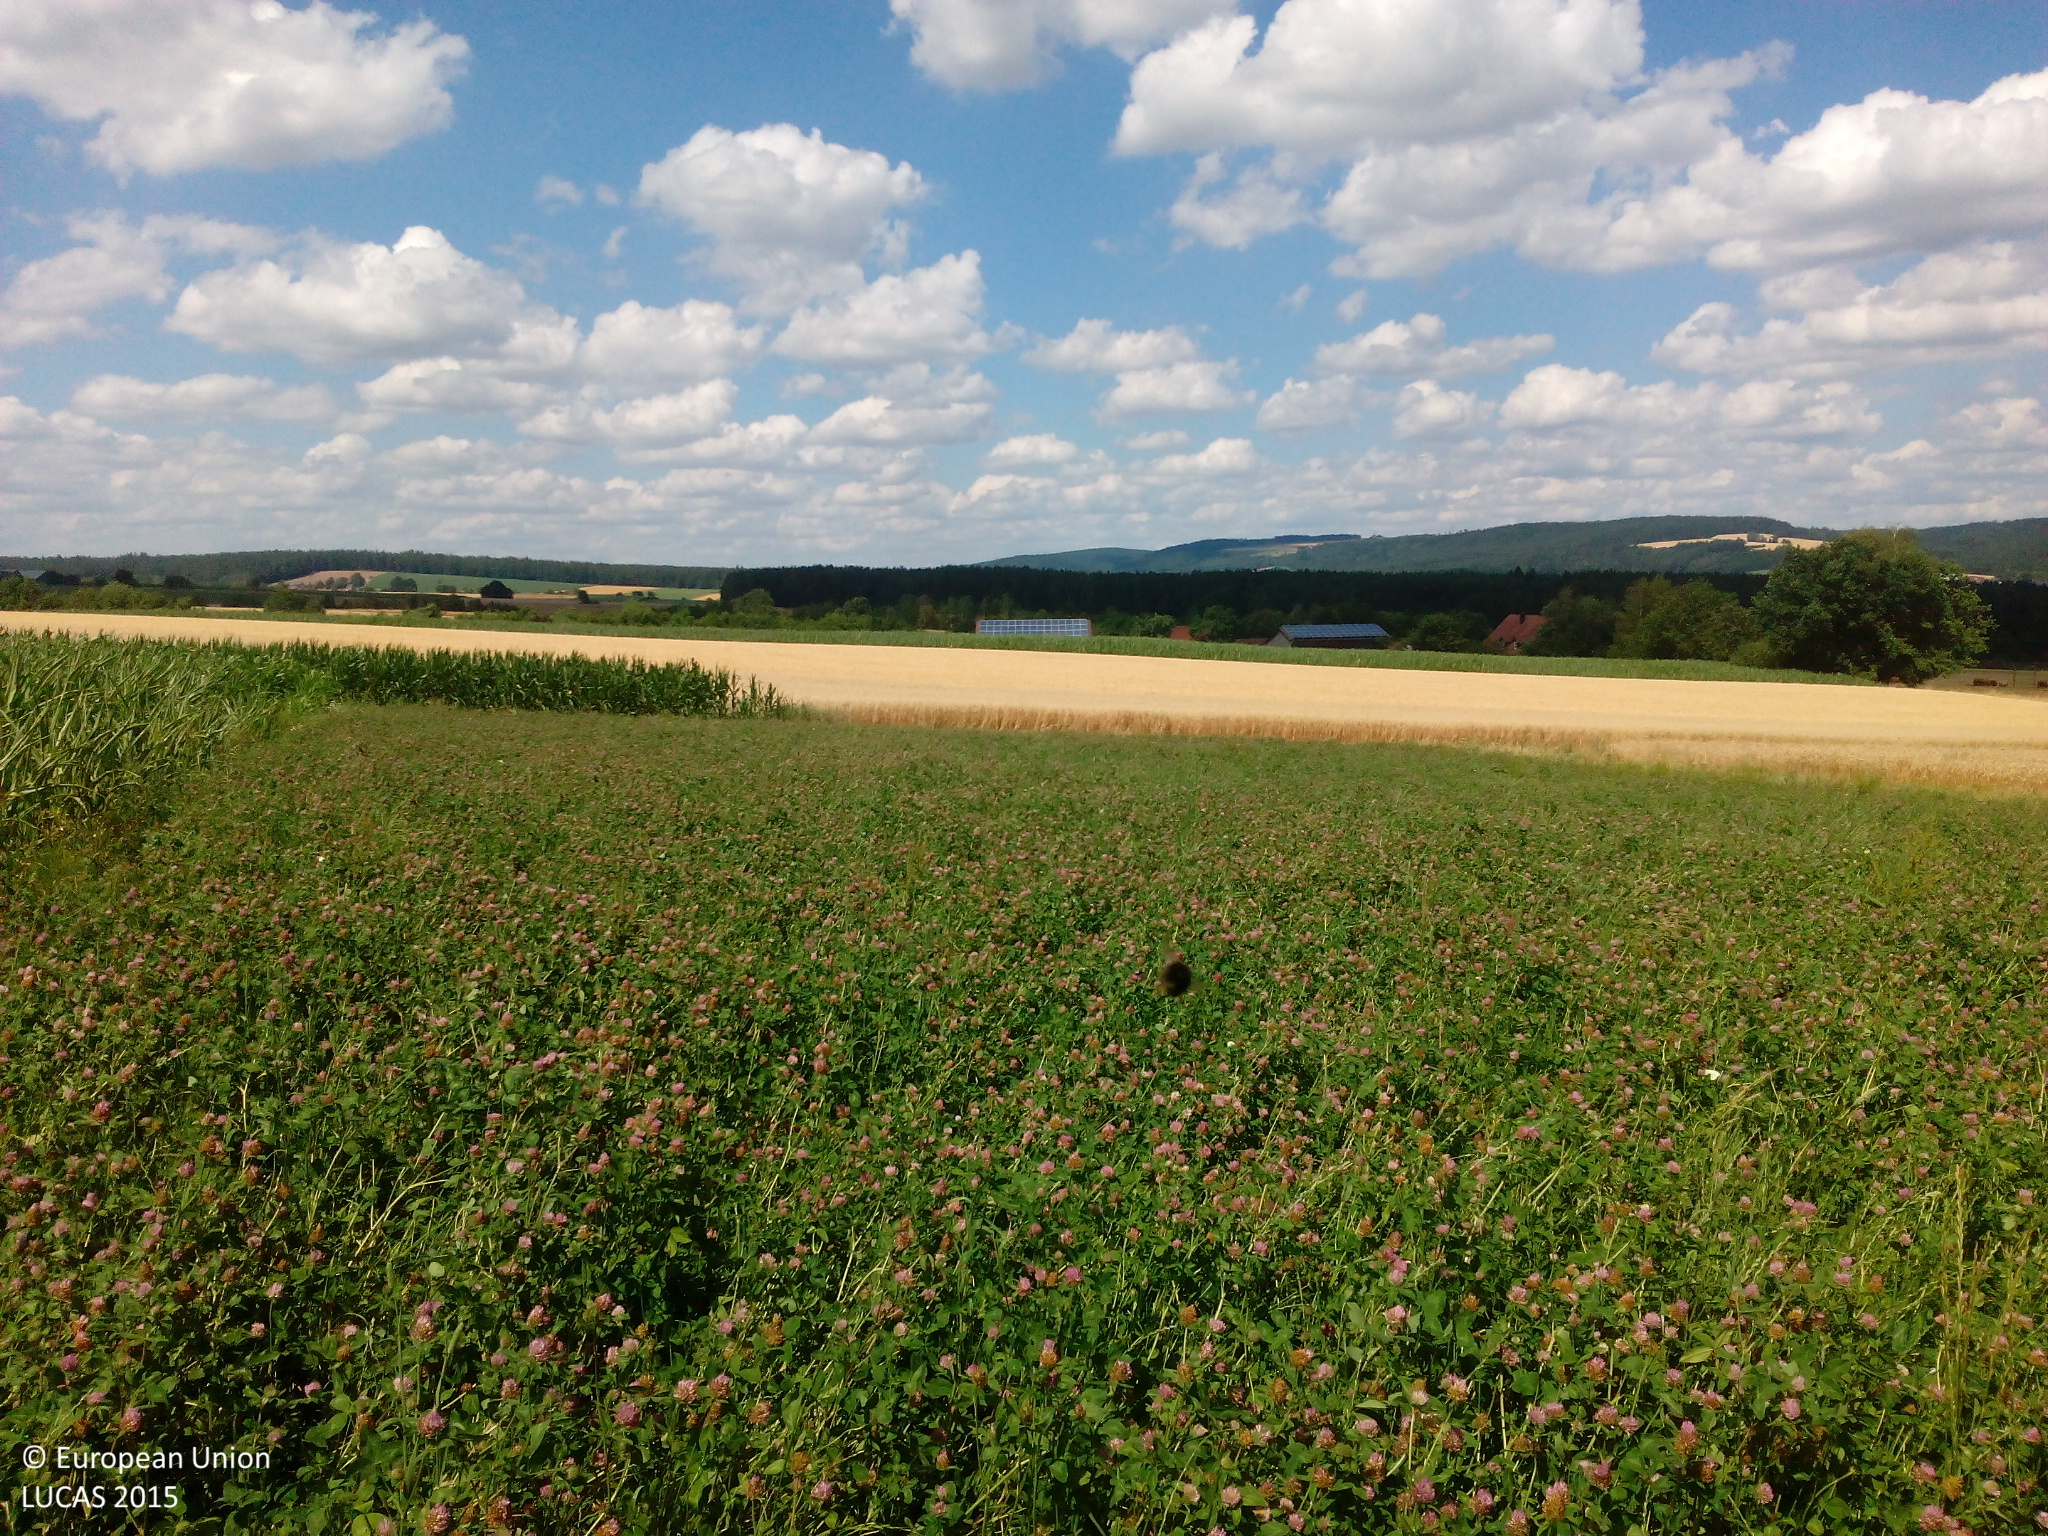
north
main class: Cropland
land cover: Clovers
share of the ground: > 75 %
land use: Agriculture (excluding fallow land and kitchen gardens)
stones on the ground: < 10 %
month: July
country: DE
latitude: 49.6053
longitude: 12.1997
